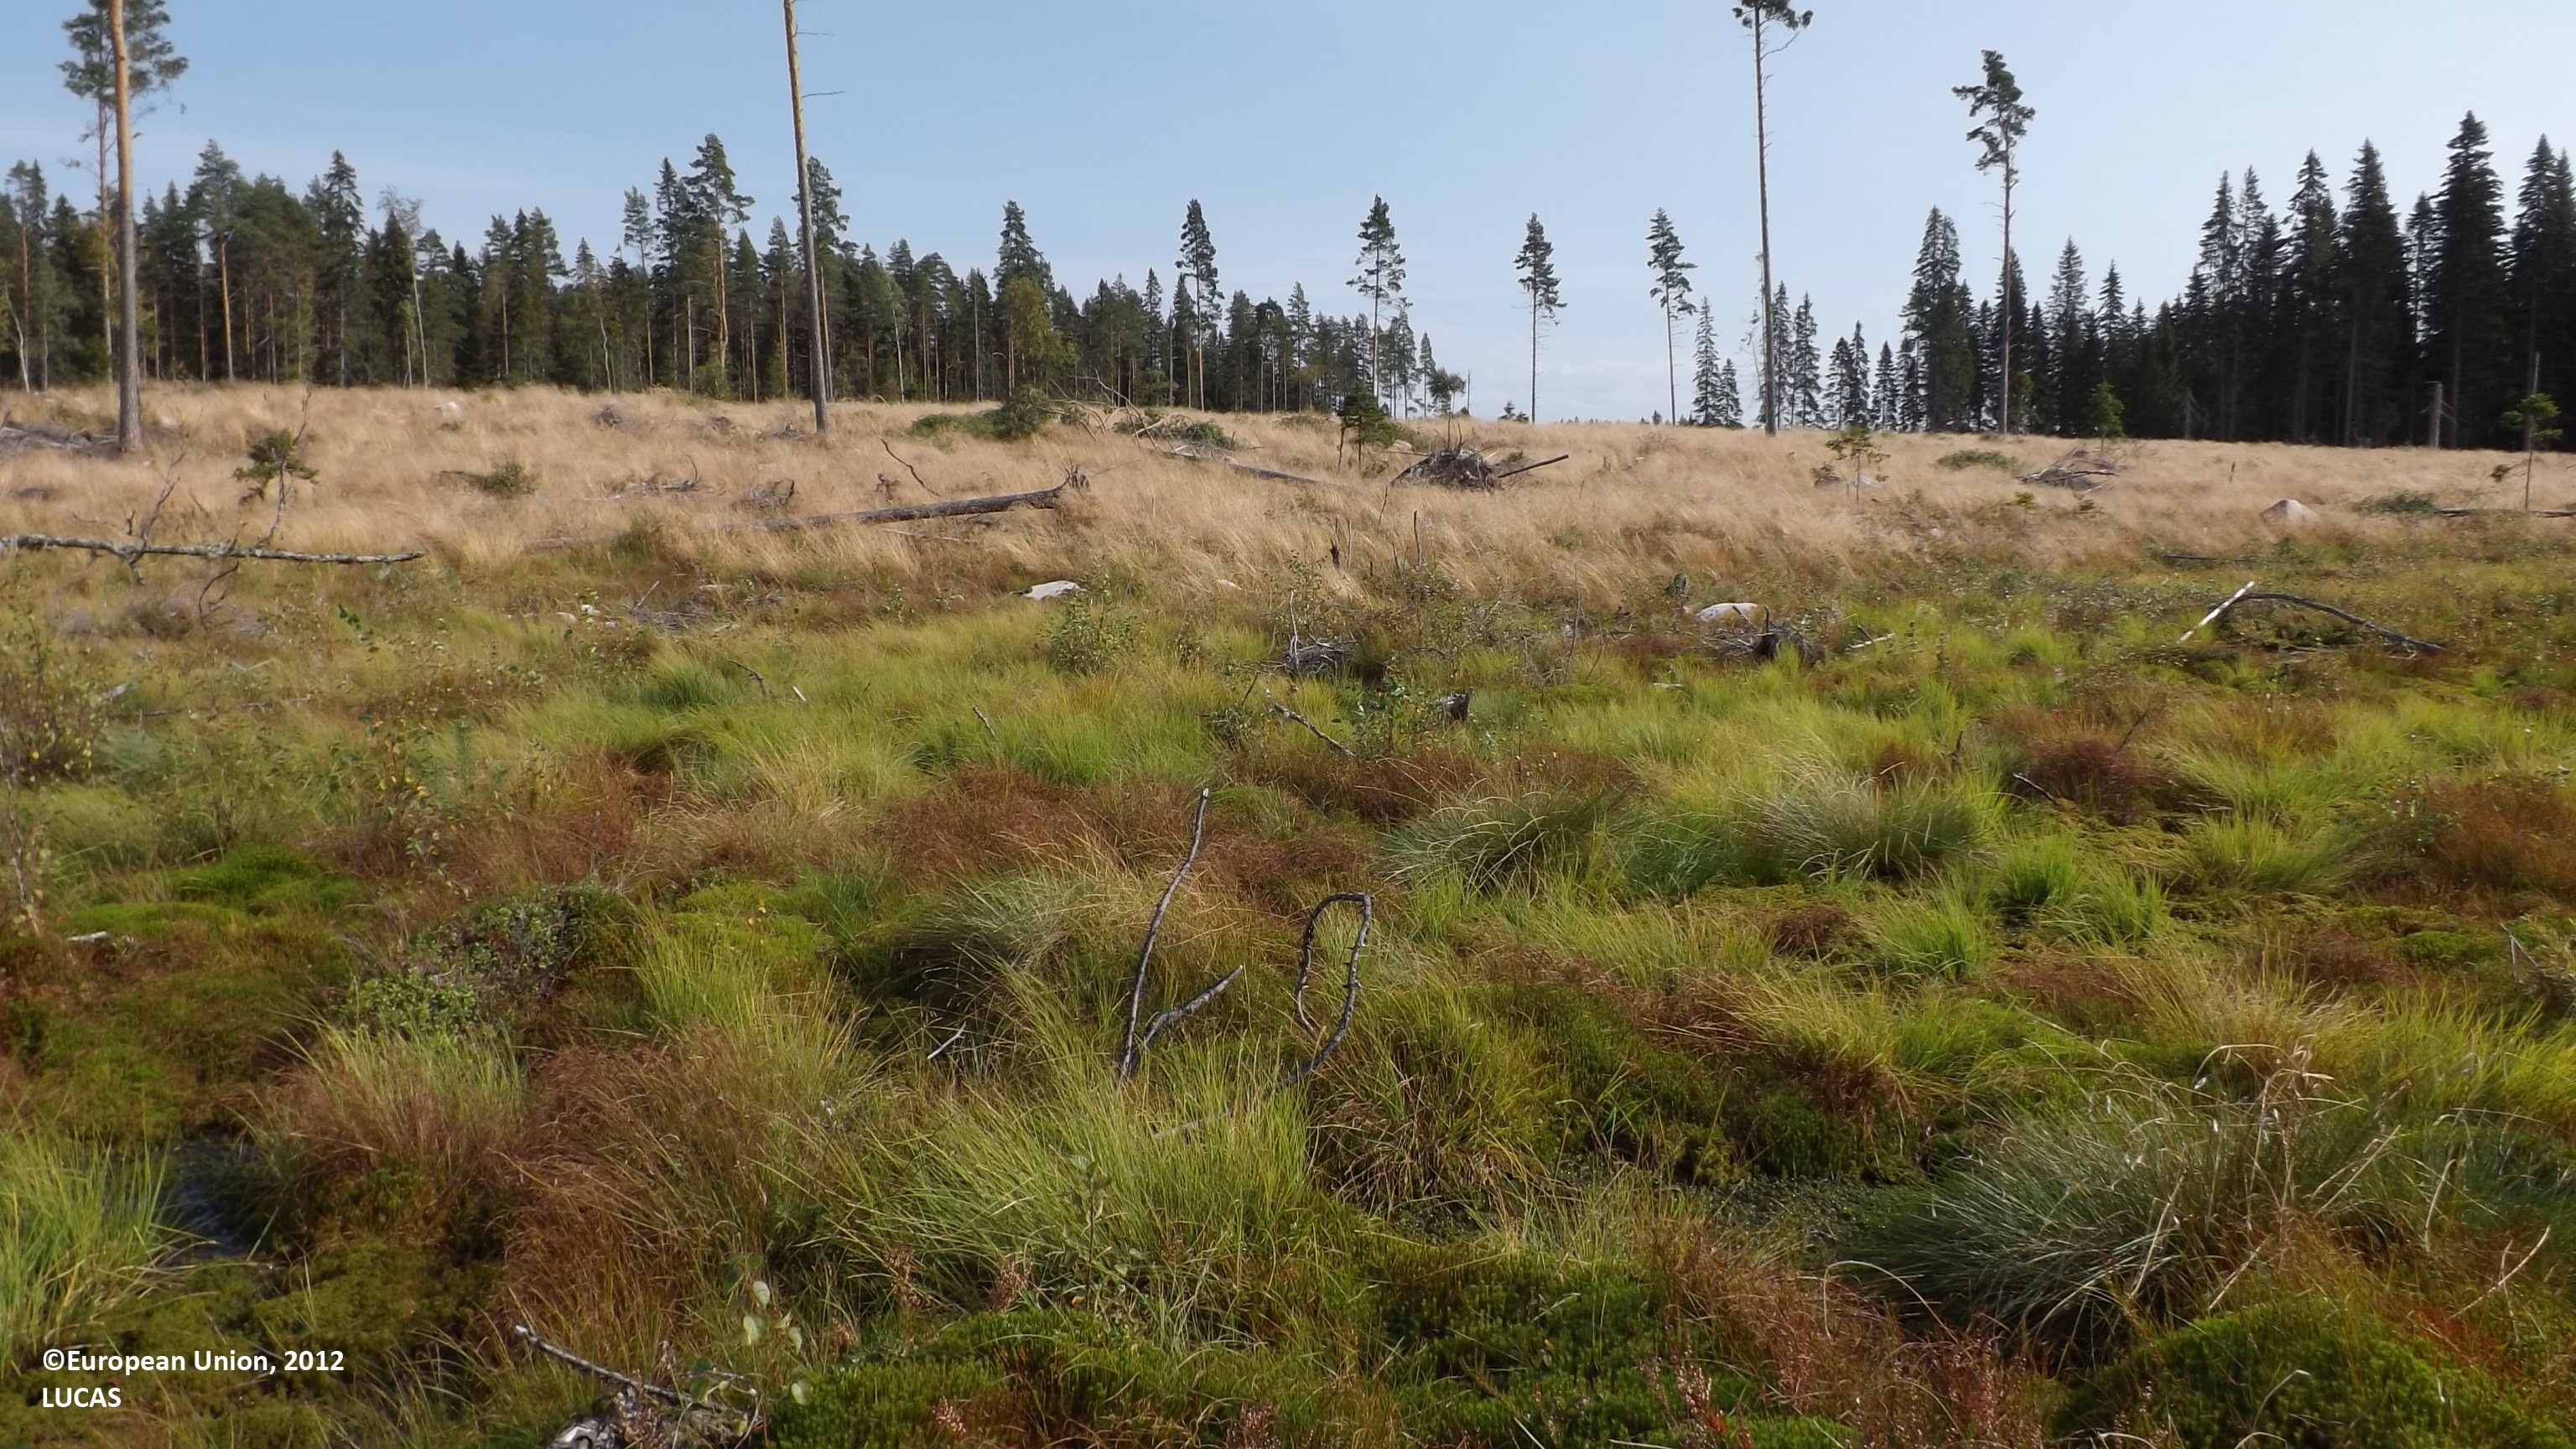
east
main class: Grassland
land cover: Grassland with sparse tree/shrub cover
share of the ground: 25 - 50 %
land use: Forestry
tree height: < 5 m
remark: Clear cut
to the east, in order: Grassland with sparse tree/shrub cover; Shrubland with sparse tree cover
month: August
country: FI
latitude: 63.7559
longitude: 23.5803
